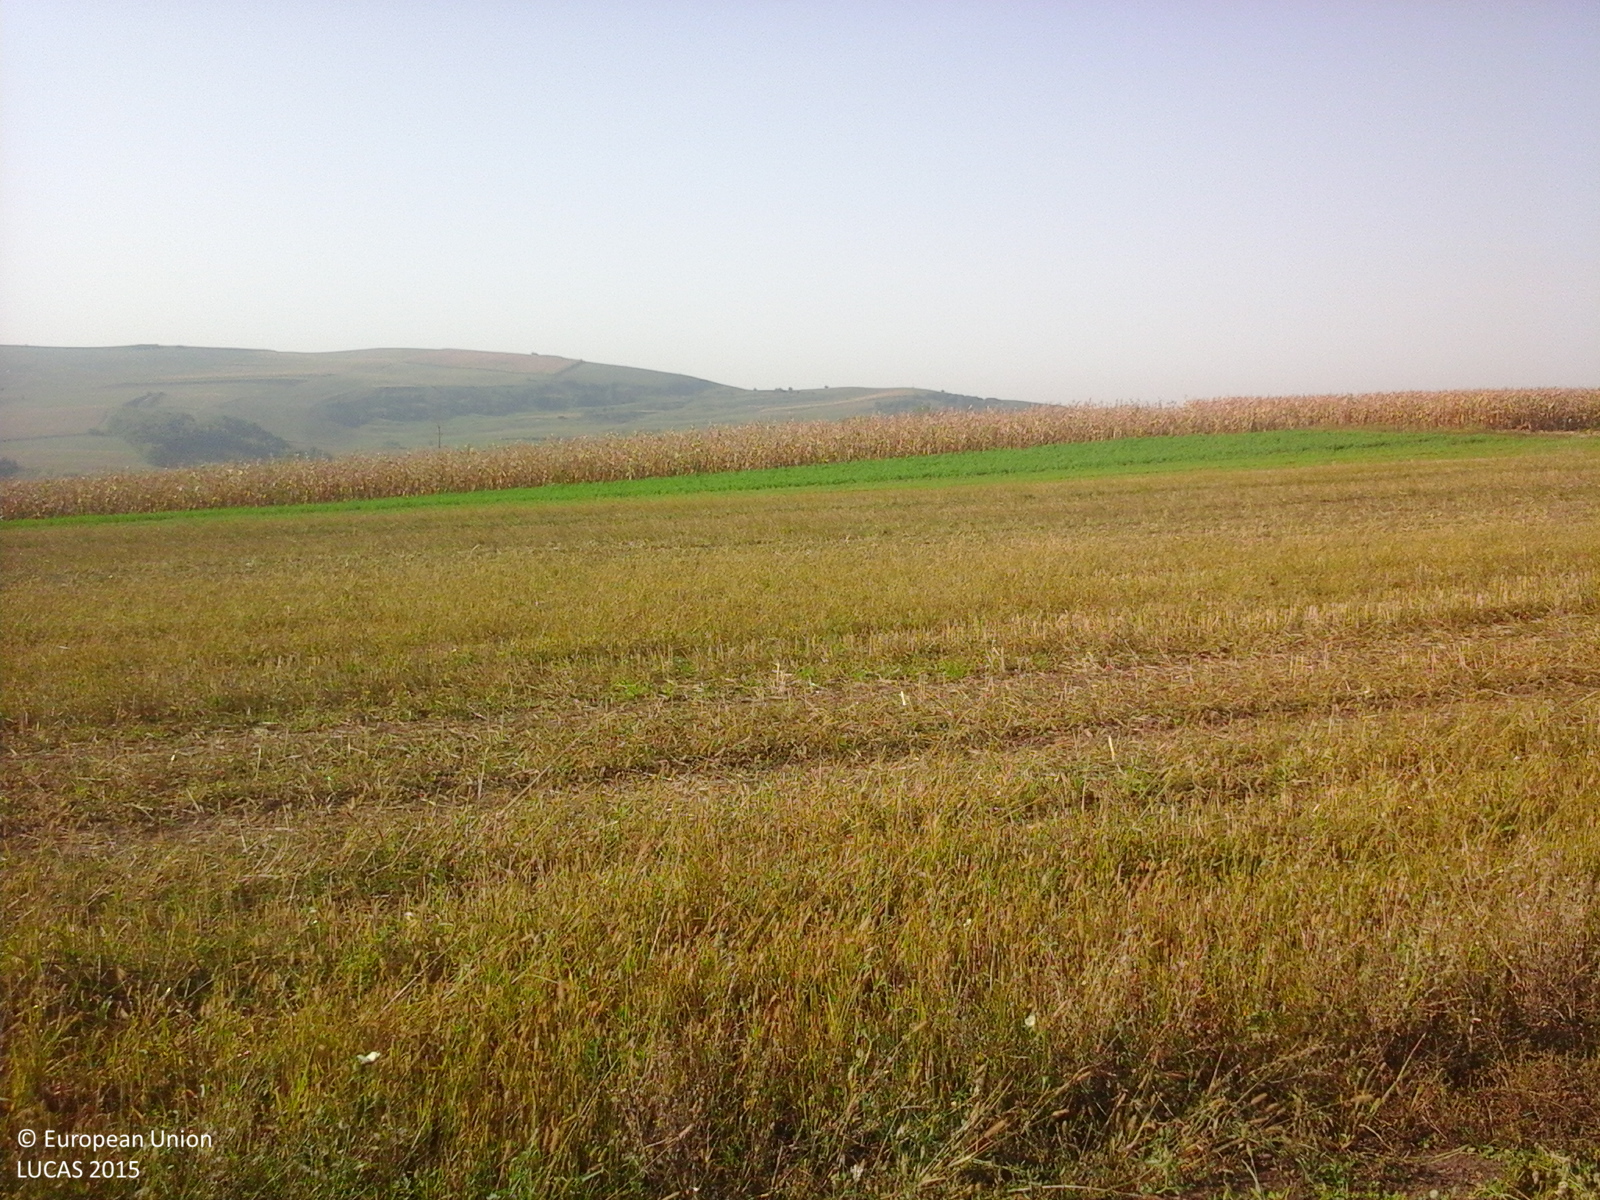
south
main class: Cropland
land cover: Lucerne
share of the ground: > 75 %
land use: Agriculture (excluding fallow land and kitchen gardens)
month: September
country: RO
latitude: 46.7027
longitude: 24.0074
